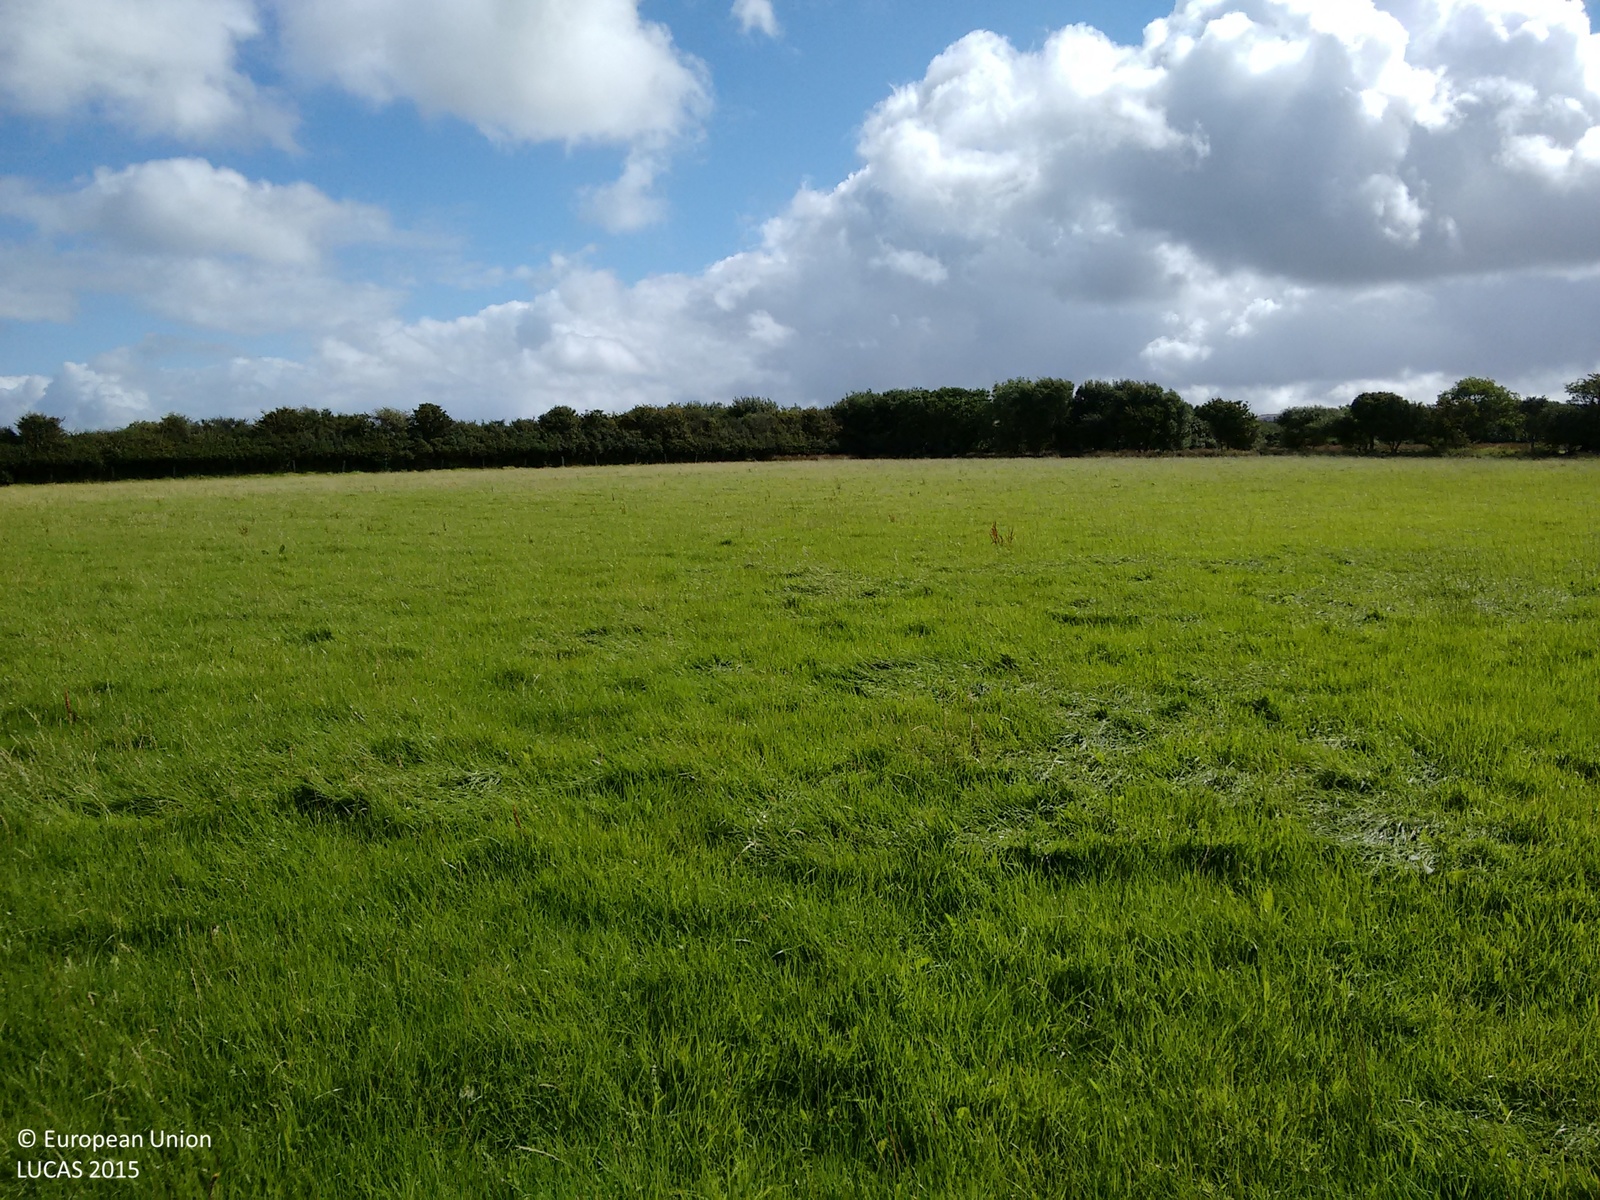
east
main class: Grassland
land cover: Grassland without tree/shrub cover
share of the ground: > 75 %
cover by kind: herbaceous plants 100 %
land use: Agriculture (excluding fallow land and kitchen gardens)
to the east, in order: Grassland without tree/shrub cover; Fences; Managed hedges; Fences; Grassland without tree/shrub cover; Fences; Managed hedges; Fences; Grassland without tree/shrub cover; Managed hedges; Fences; Grassland without tree/shrub cover; Fences; Grassland without tree/shrub cover
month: August
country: GB
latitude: 52.0148
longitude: -4.9040
